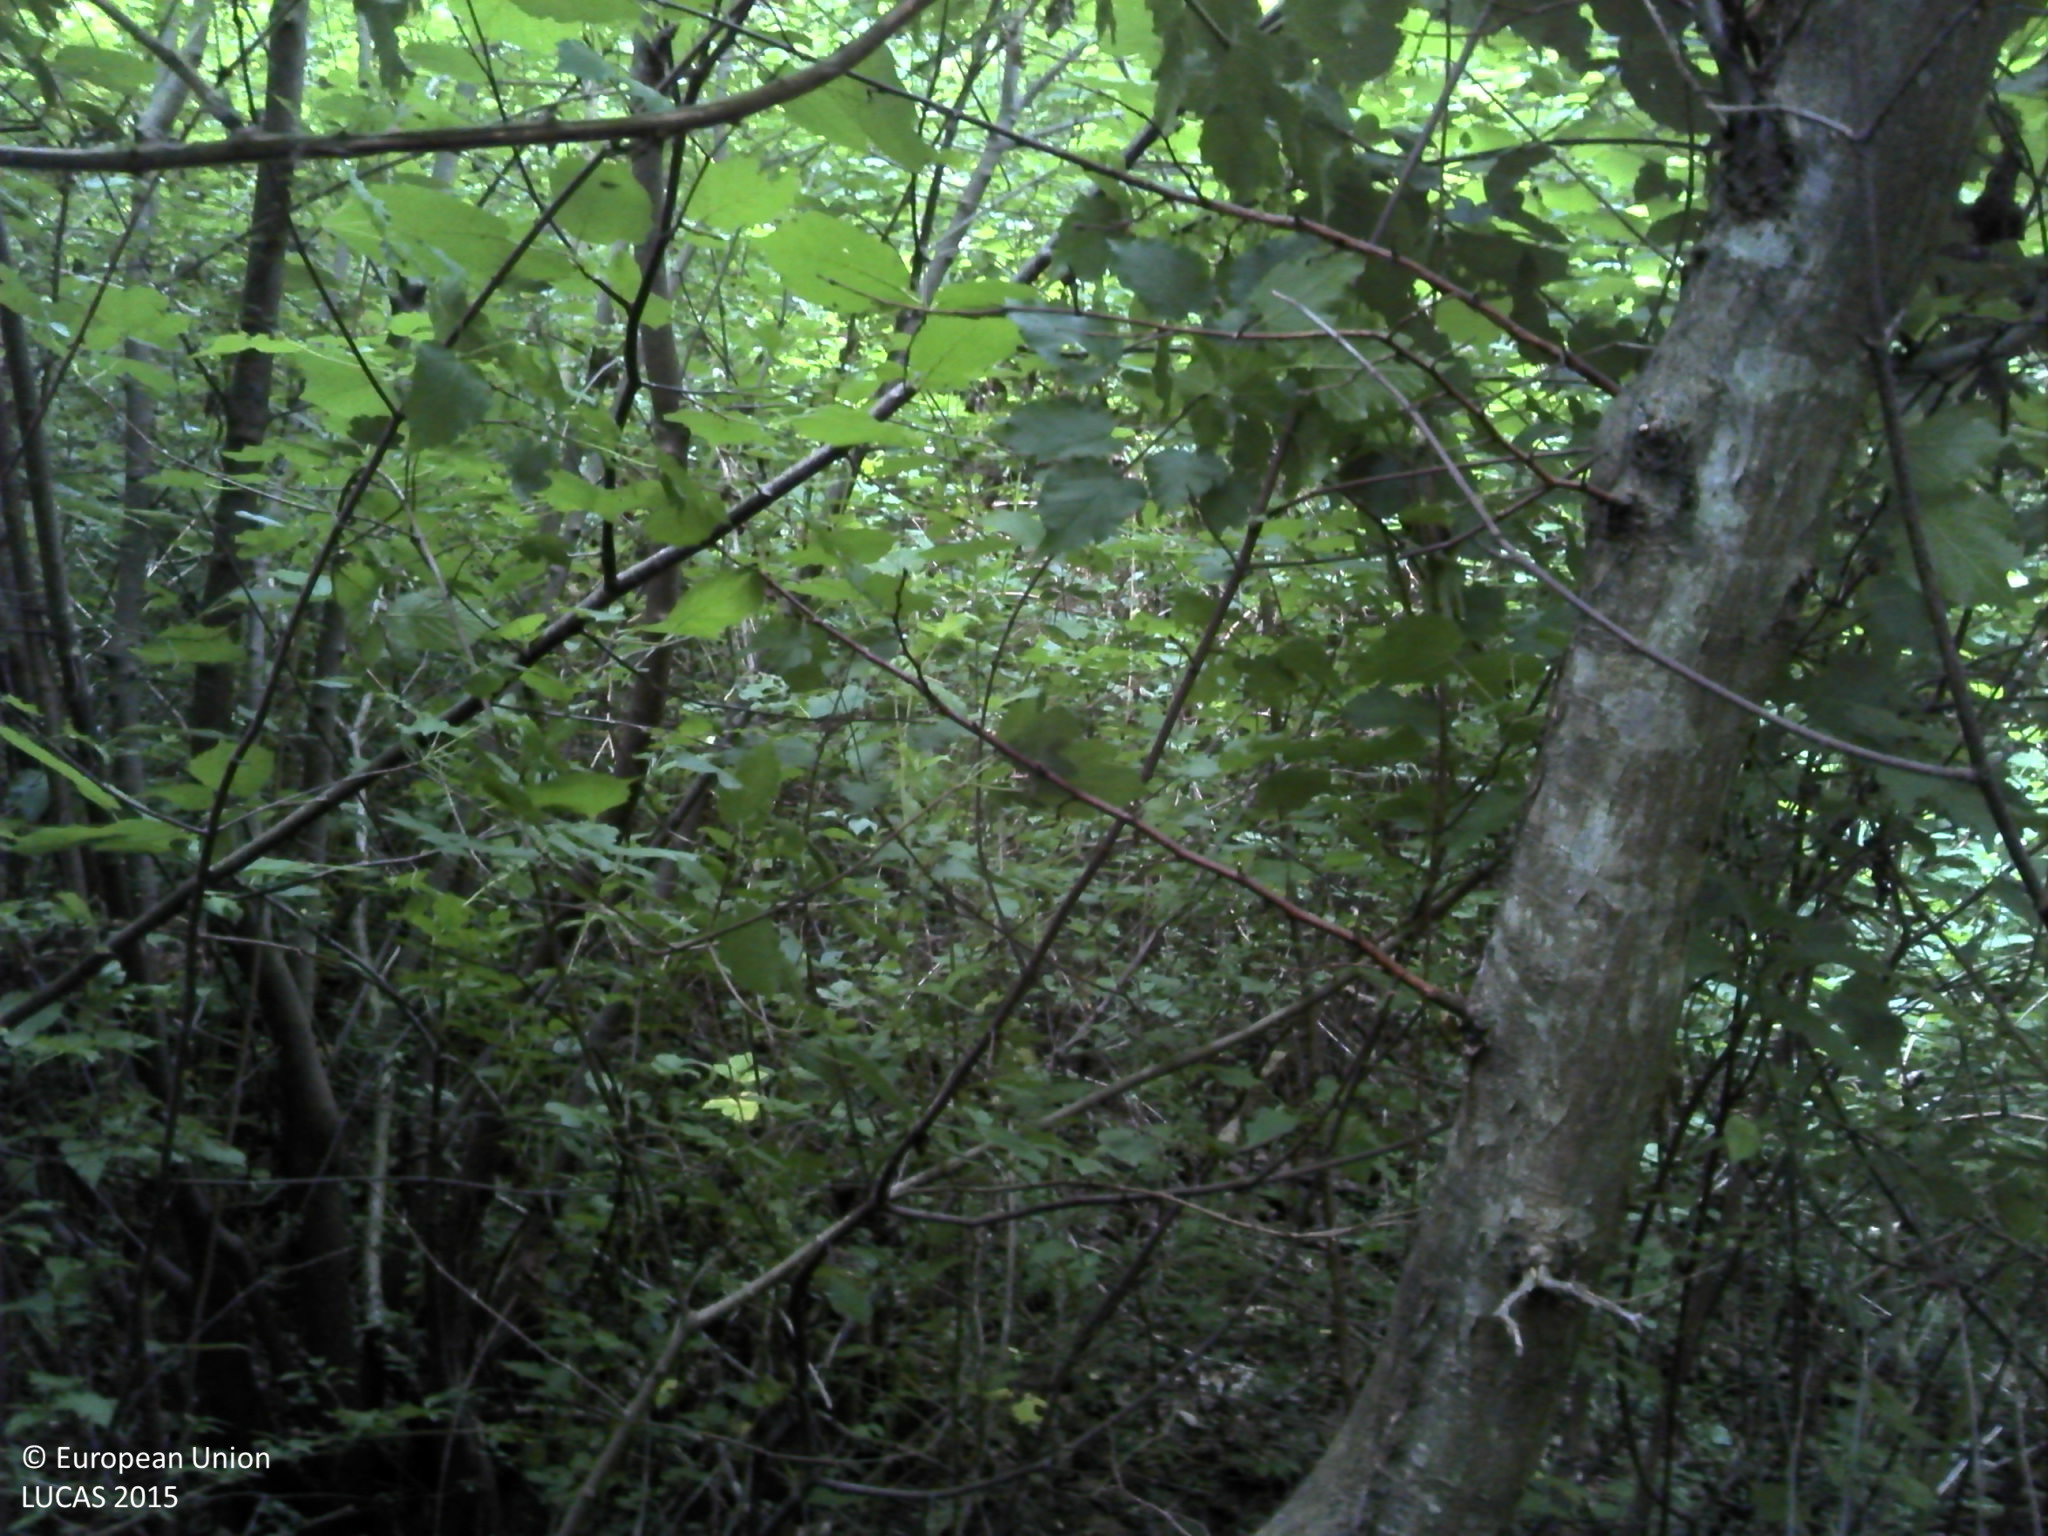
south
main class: Woodland
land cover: Broadleaved woodland
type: beech forest
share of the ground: > 75 %
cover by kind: broadleaved forest trees 100 %
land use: Forestry
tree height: > 5 m
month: June
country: HR
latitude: 45.2508
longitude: 17.8124
